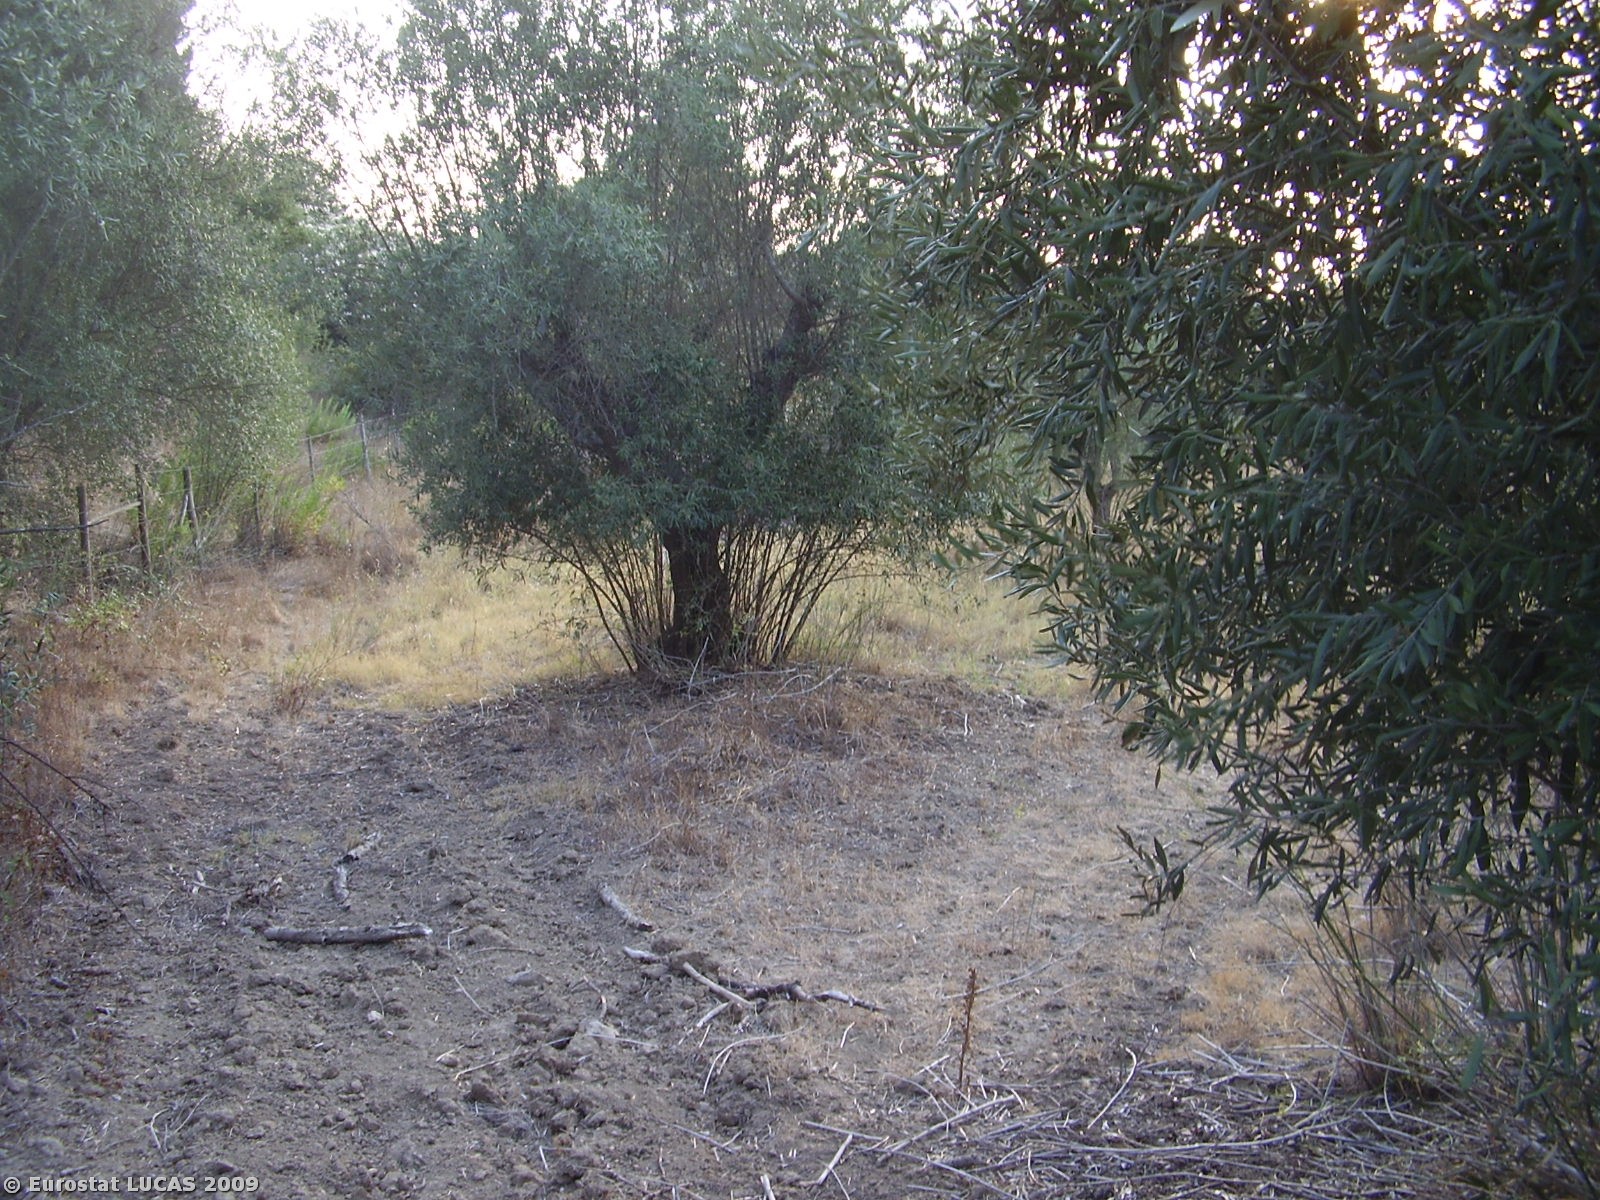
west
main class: Cropland
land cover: Olive groves
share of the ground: 10 - 25 %
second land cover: Spontaneously vegetated surfaces
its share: 50 - 75 %
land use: Agriculture (excluding fallow land and kitchen gardens)
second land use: Fallow land
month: August
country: PT
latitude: 38.2345
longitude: -8.0061
